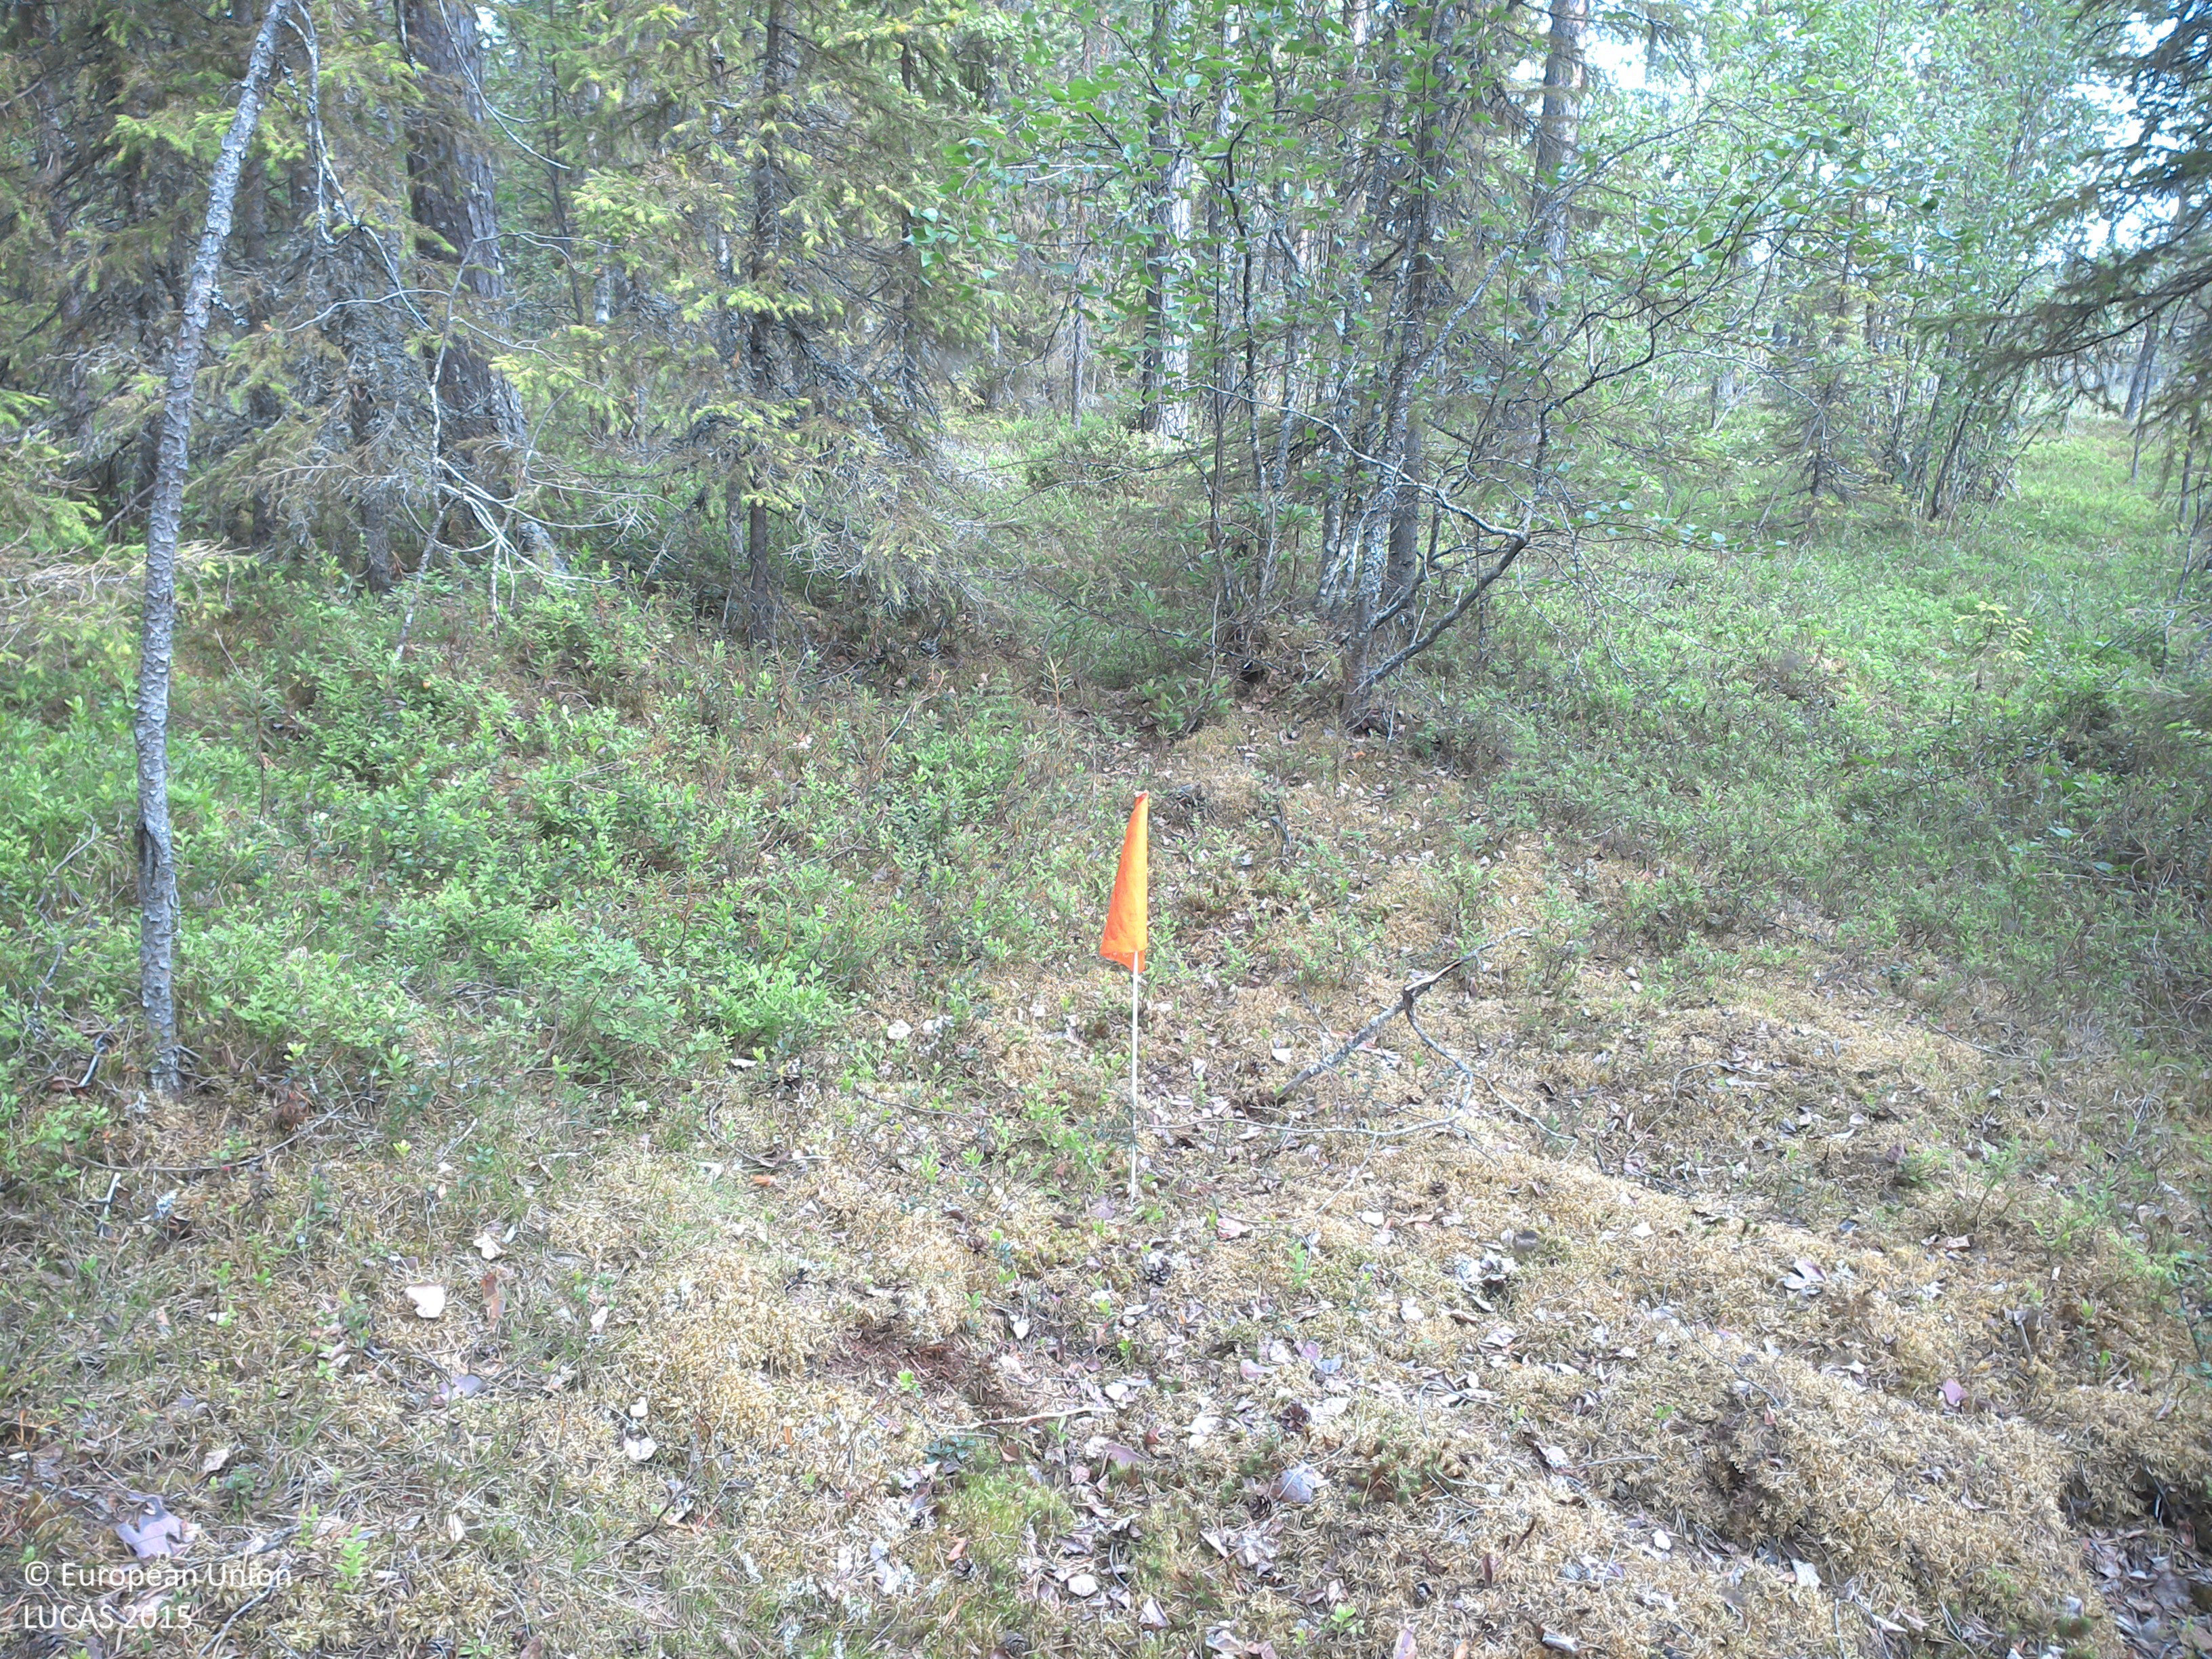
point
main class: Woodland
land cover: Pine dominated mixed woodland
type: boreal forest
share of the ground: 25 - 50 %
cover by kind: shrubs 50 %, coniferous forest trees 20 %, lichens and mosses 20 %, broadleaved forest trees 10 %
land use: Forestry
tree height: > 5 m
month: July
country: SE
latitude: 67.3619
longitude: 22.6496
